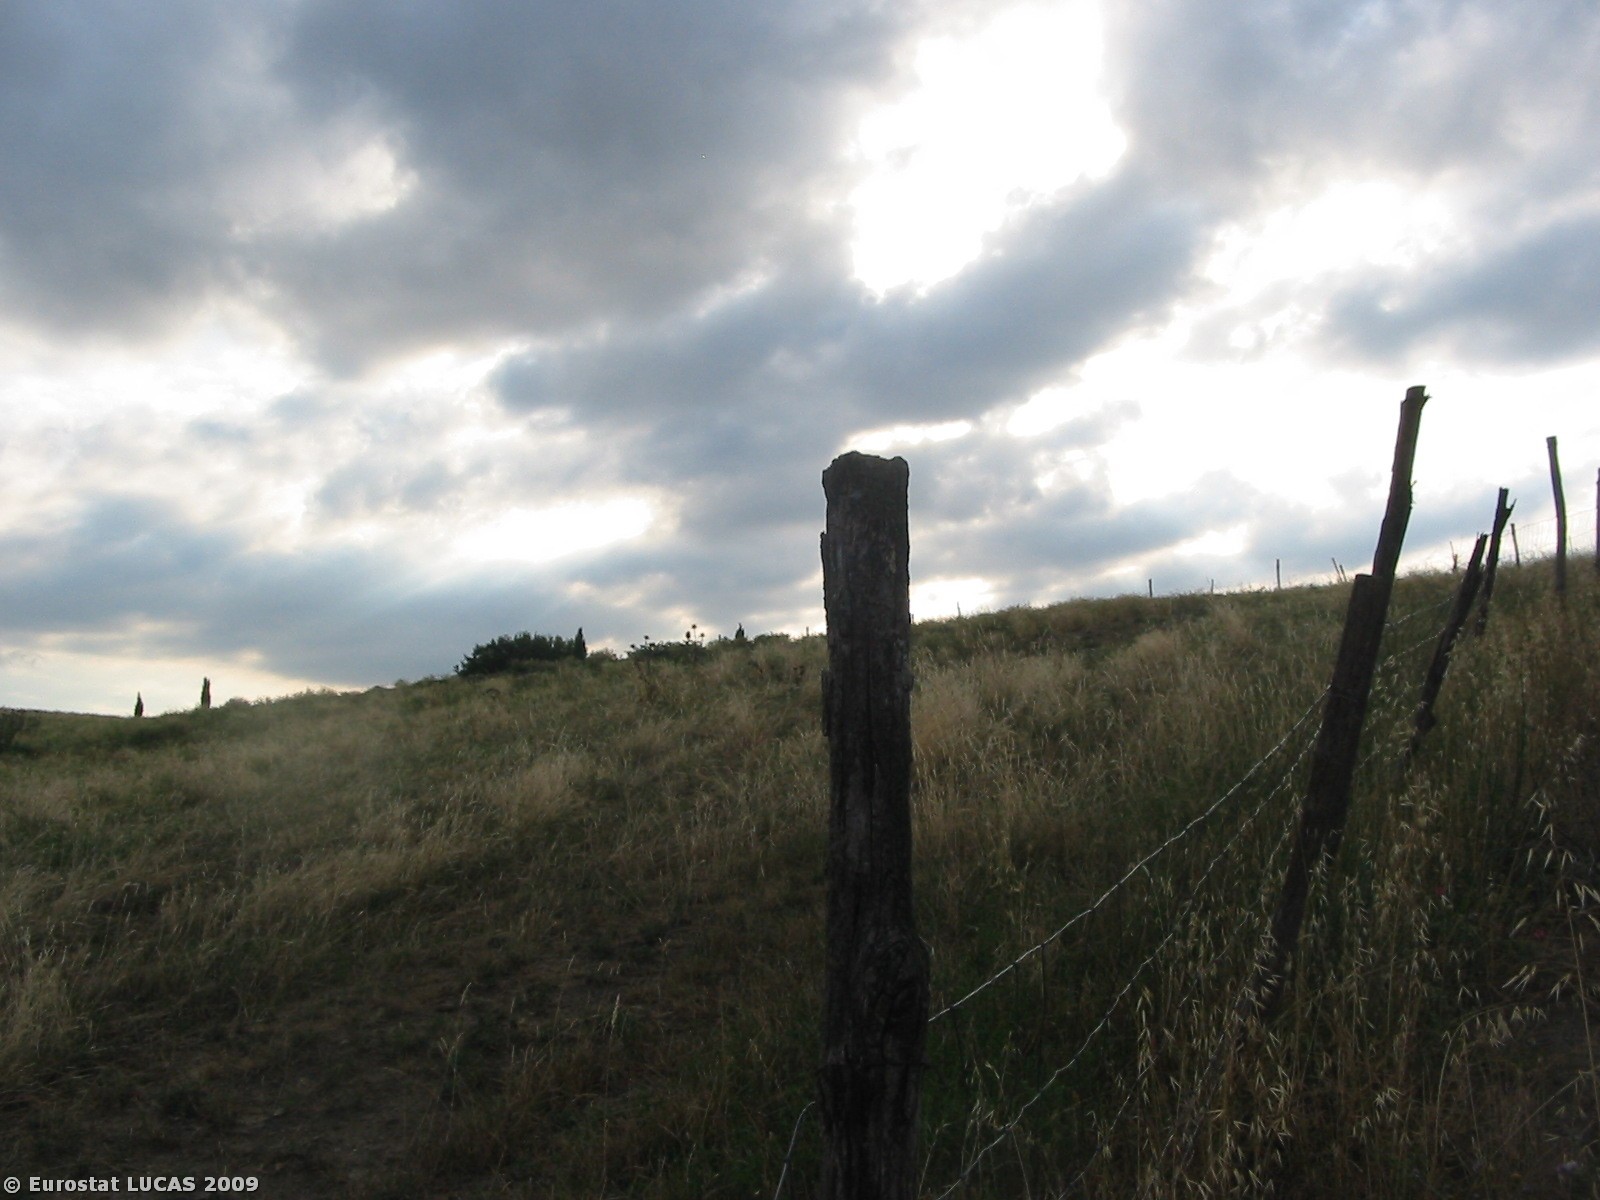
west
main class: Cropland
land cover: Lucerne
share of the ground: > 75 %
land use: Agriculture (excluding fallow land and kitchen gardens)
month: June
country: IT
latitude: 43.0740
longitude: 11.6530
